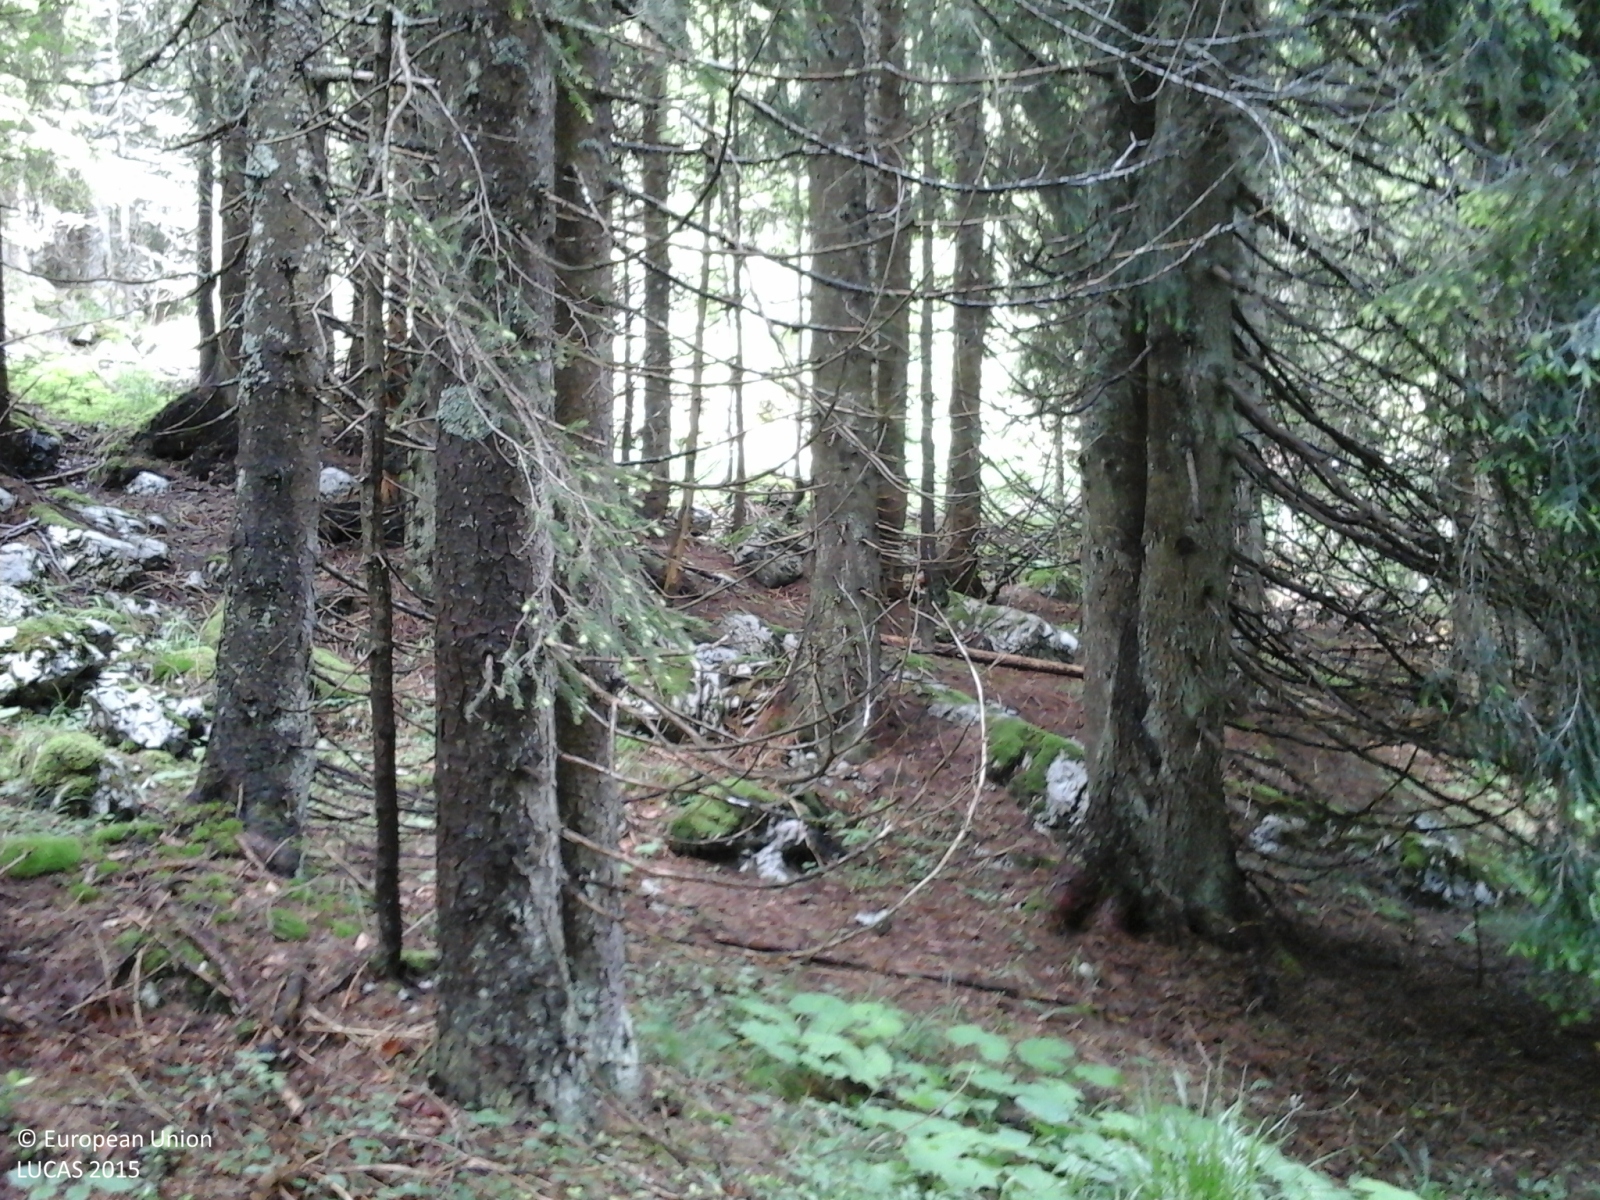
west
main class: Woodland
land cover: Spruce dominated coniferous woodland
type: alpine coniferous forest
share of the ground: > 75 %
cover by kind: coniferous forest trees 100 %
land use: Forestry
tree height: > 5 m
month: June
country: IT
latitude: 45.9438
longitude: 11.5328
